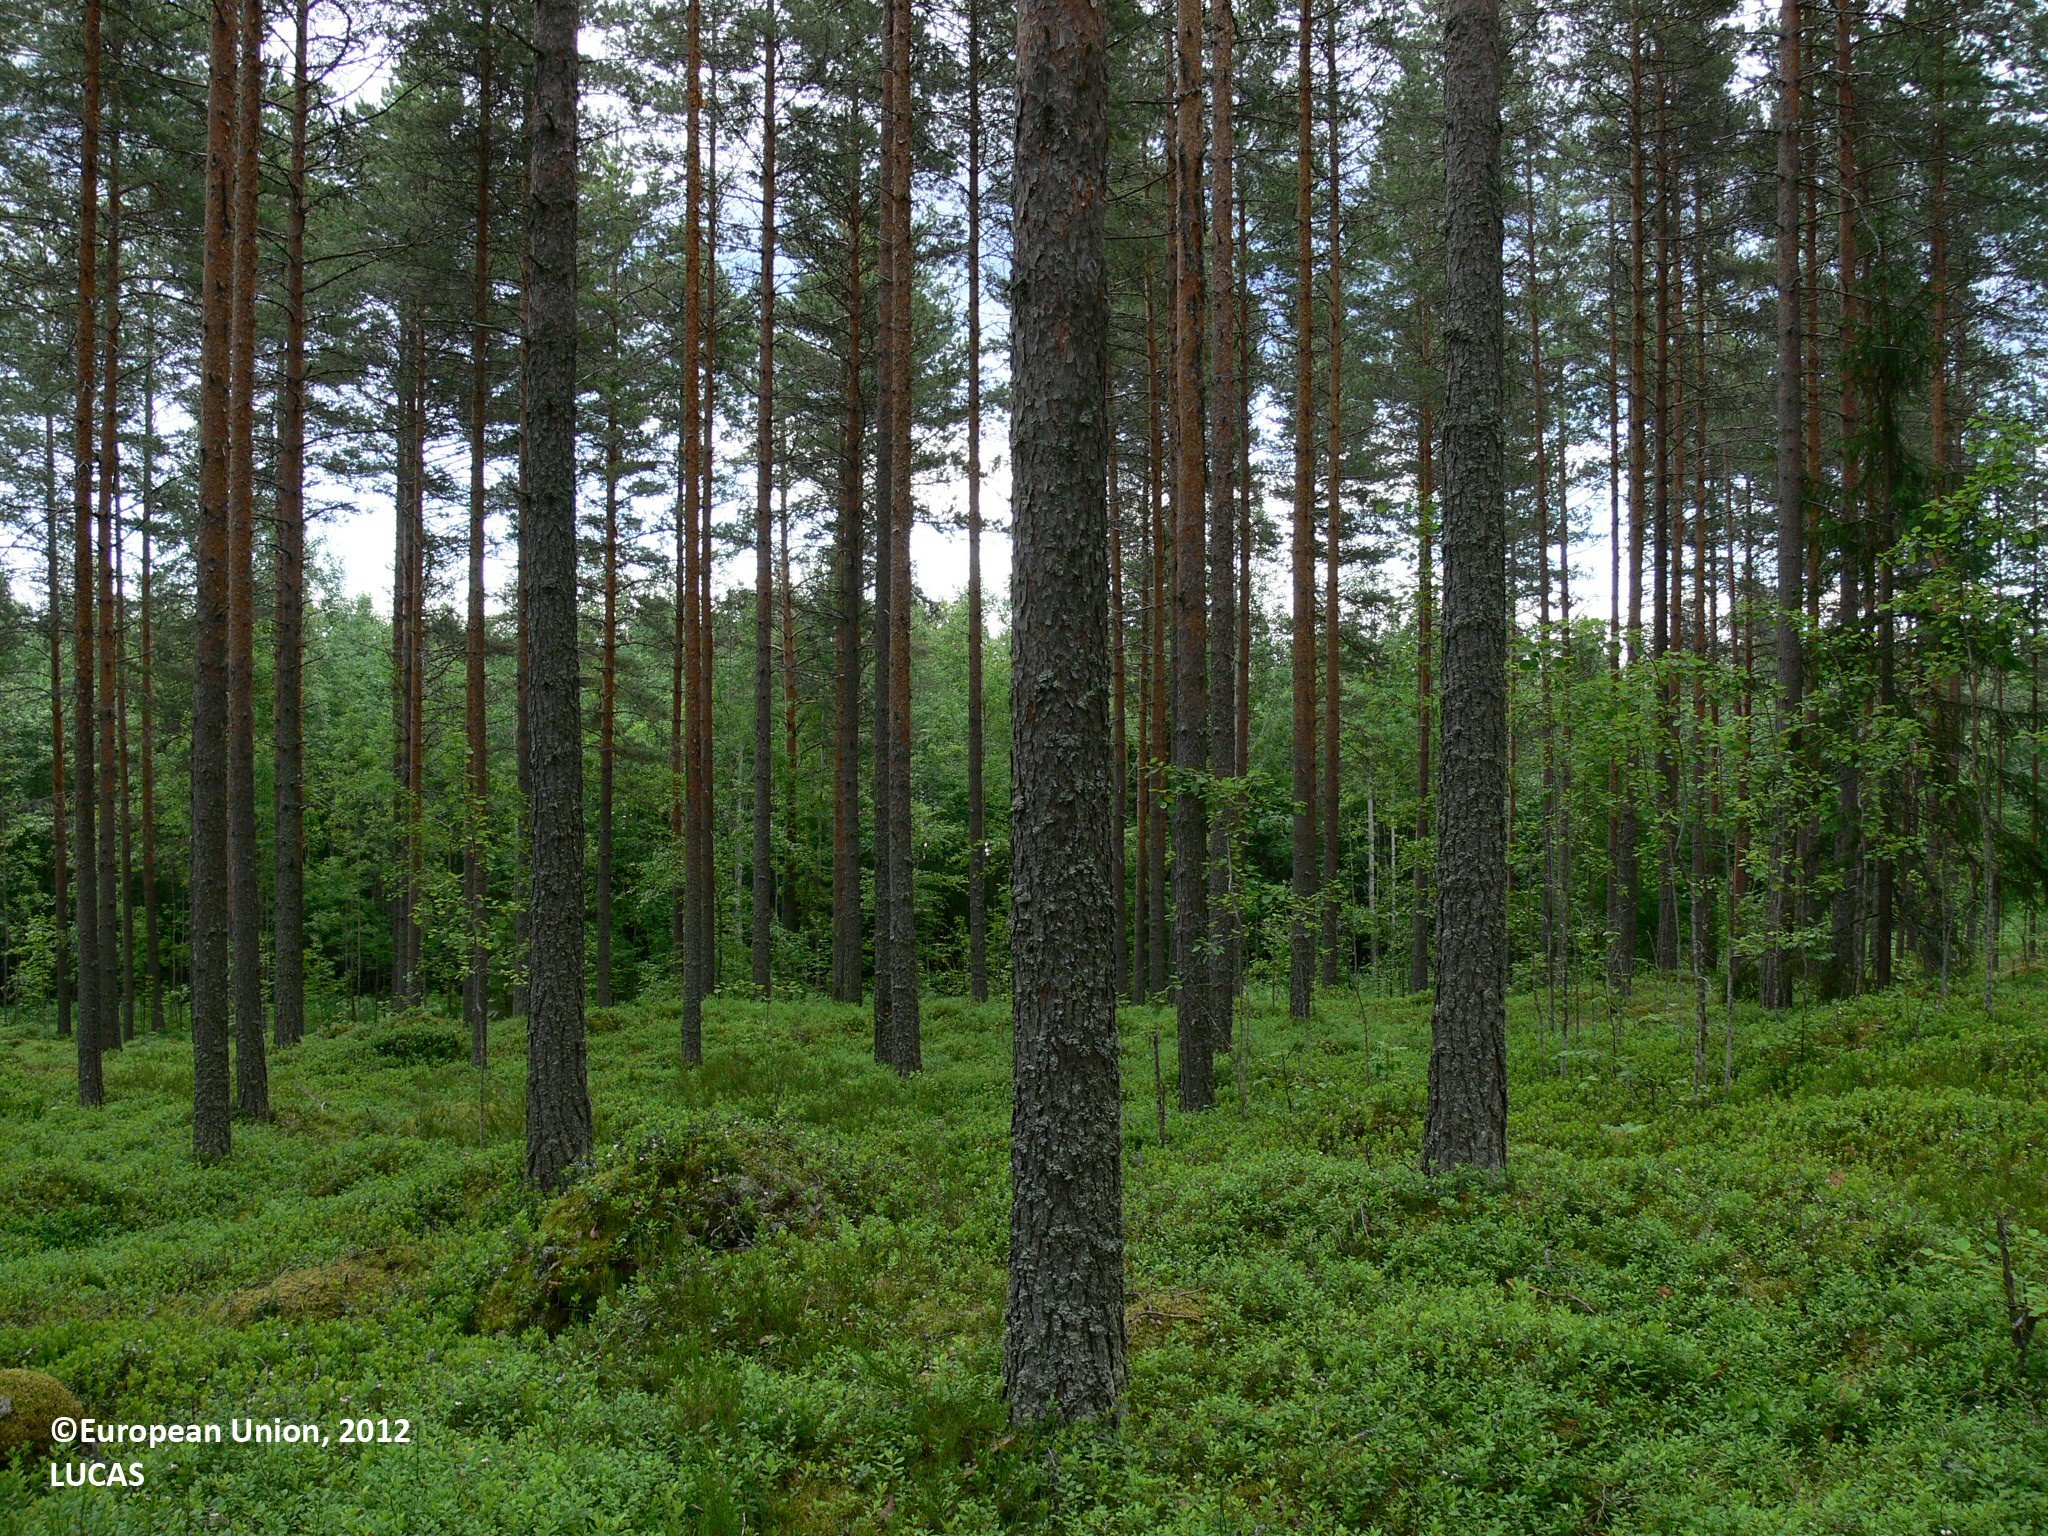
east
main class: Woodland
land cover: Pine dominated coniferous woodland
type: boreal forest
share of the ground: > 75 %
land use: Forestry
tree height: > 5 m
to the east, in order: Pine dominated coniferous woodland; Tracks; Other mixed woodland; Broadleaved woodland; Inland marshes; Inland water bodies
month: June
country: FI
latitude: 62.3984
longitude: 29.6518
